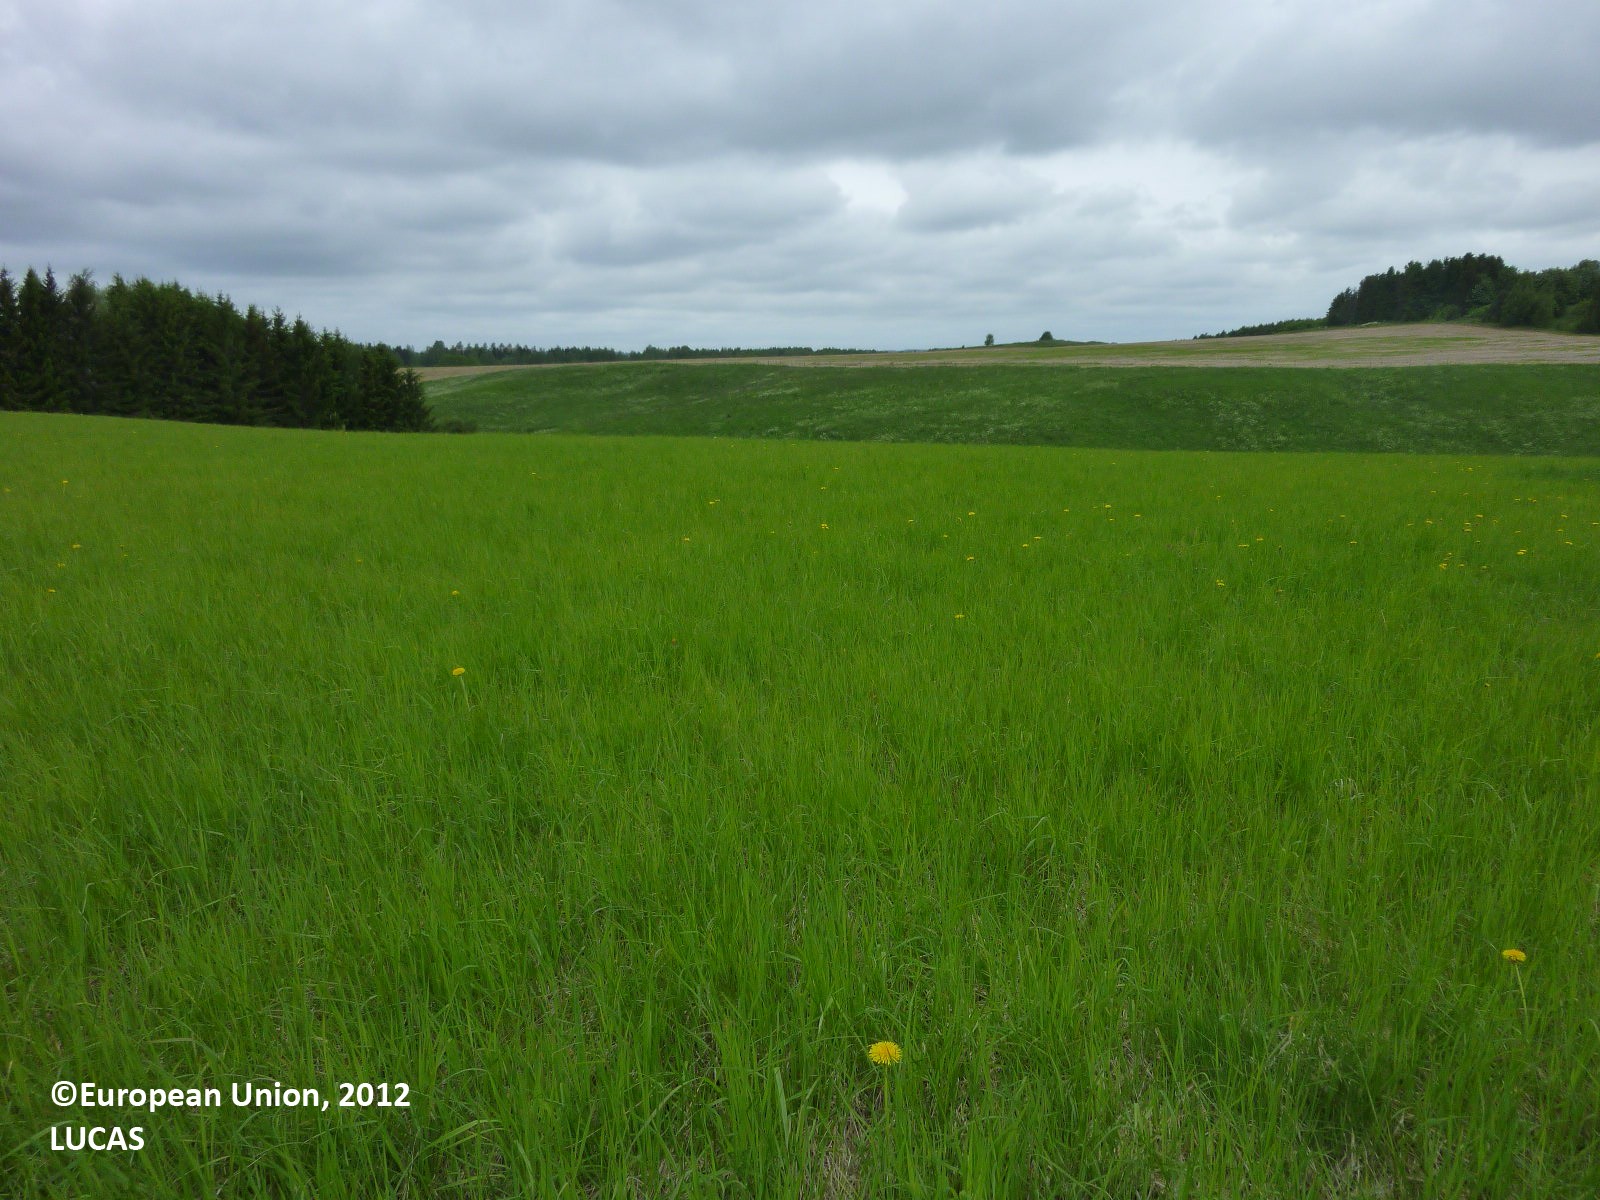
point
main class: Cropland
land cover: Temporary grasslands
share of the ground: > 75 %
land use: Agriculture (excluding fallow land and kitchen gardens)
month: June
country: FI
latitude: 60.4614
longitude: 22.7115
